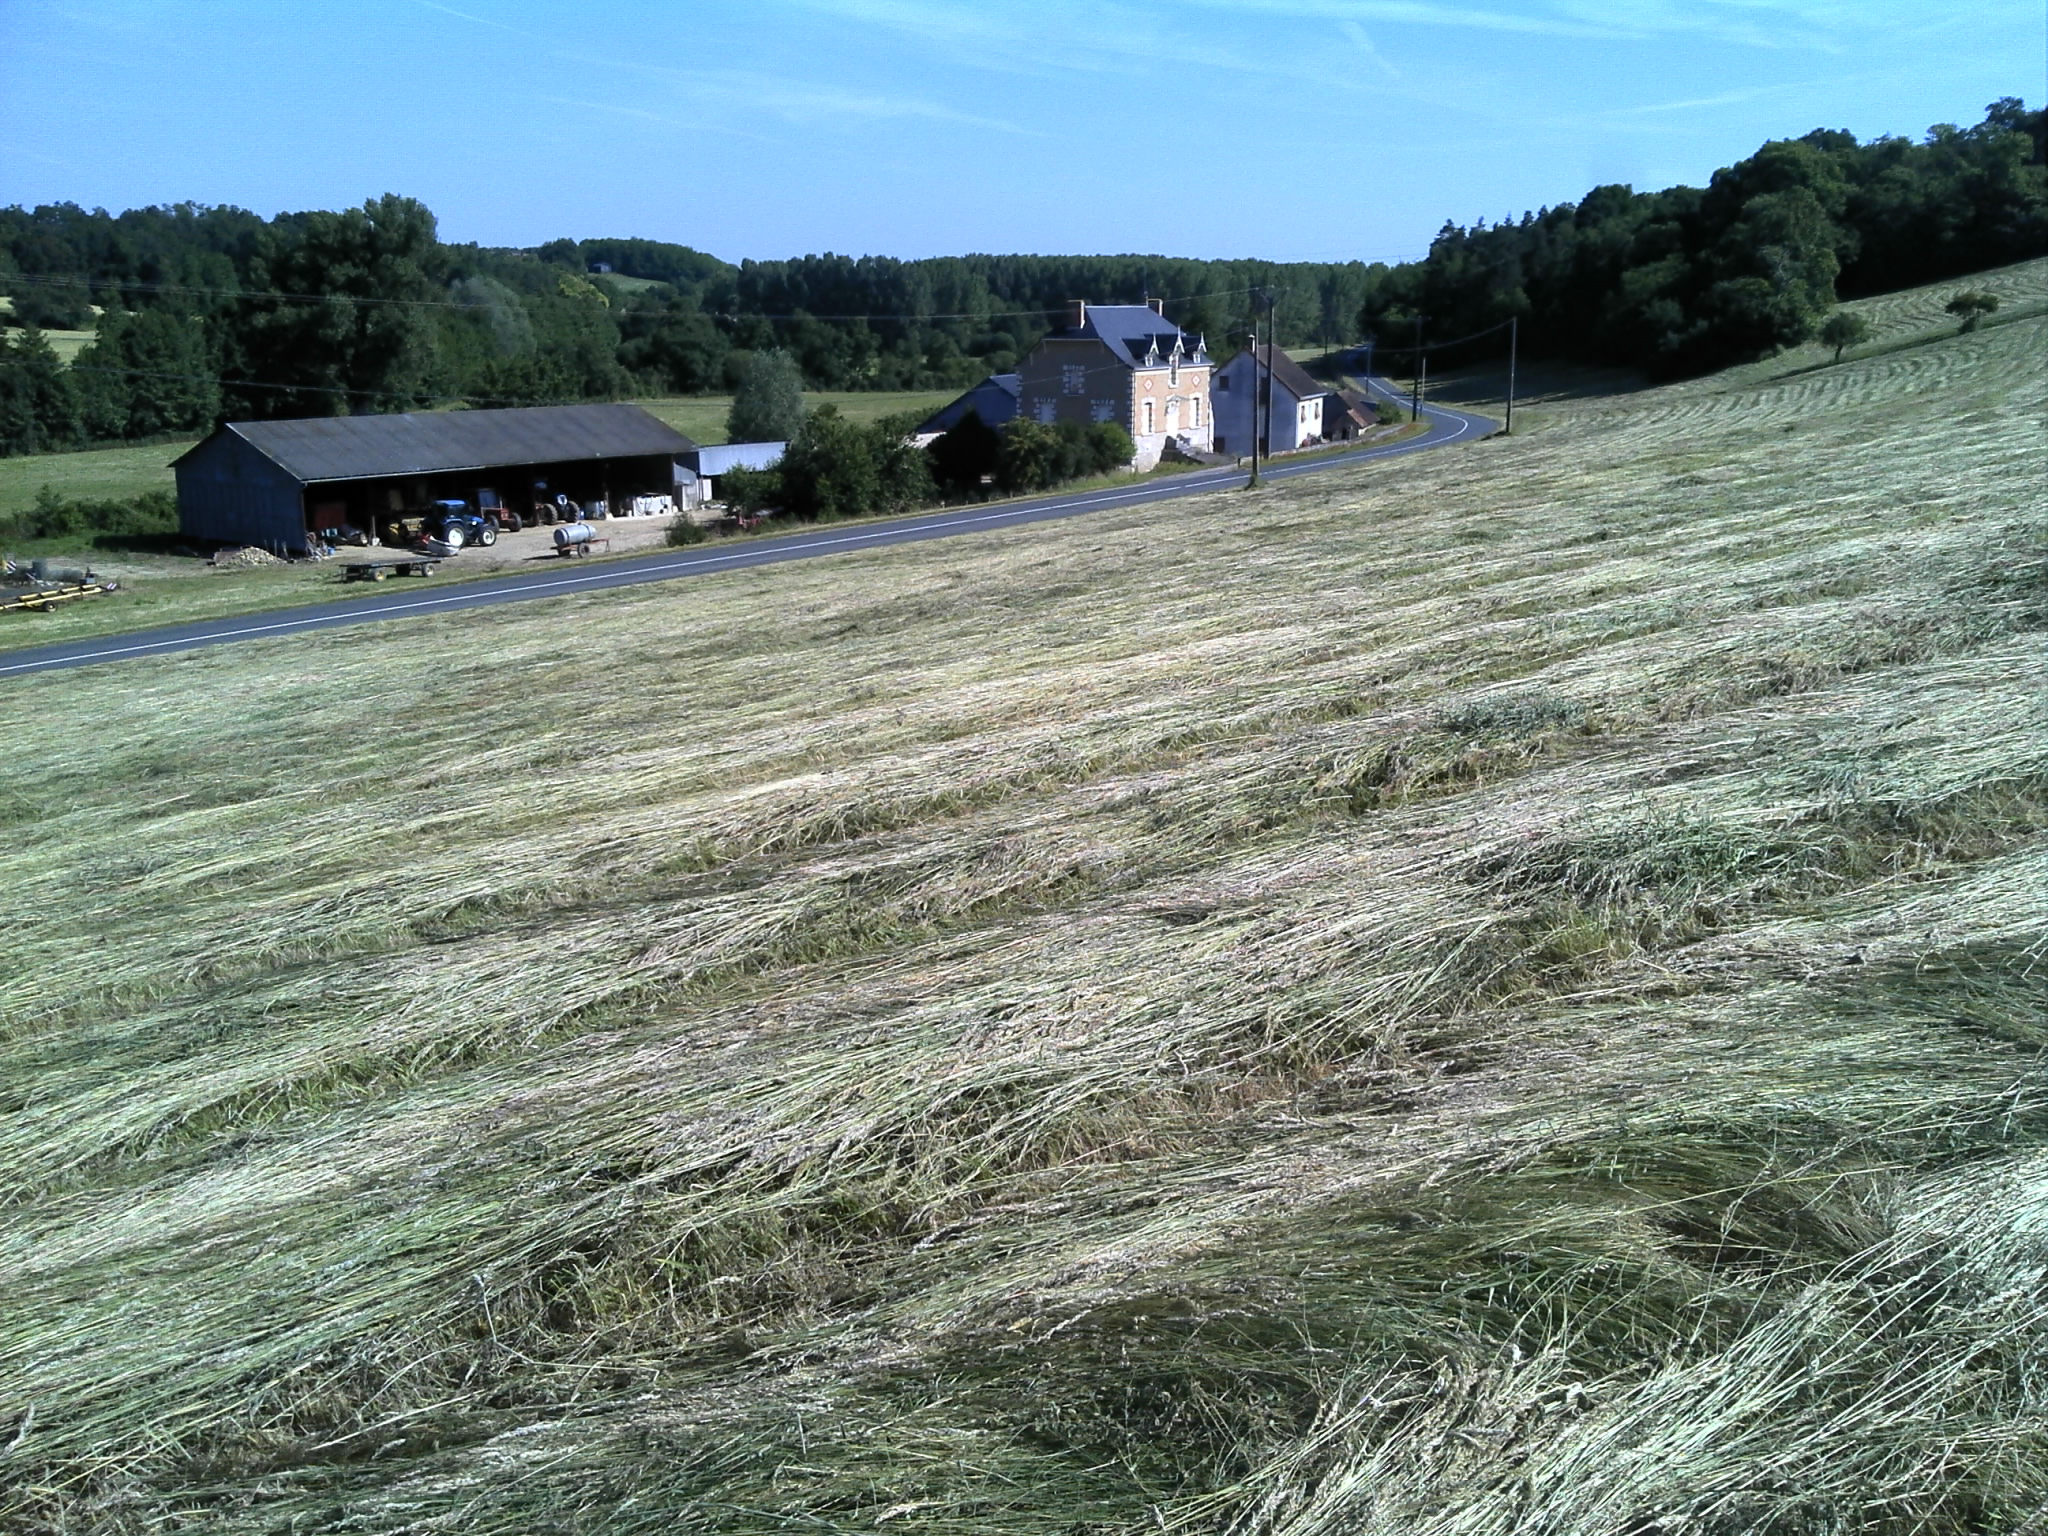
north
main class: Grassland
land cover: Grassland without tree/shrub cover
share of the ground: > 75 %
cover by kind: herbaceous plants 100 %
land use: Agriculture (excluding fallow land and kitchen gardens)
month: June
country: FR
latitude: 47.2050
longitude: 1.4719
